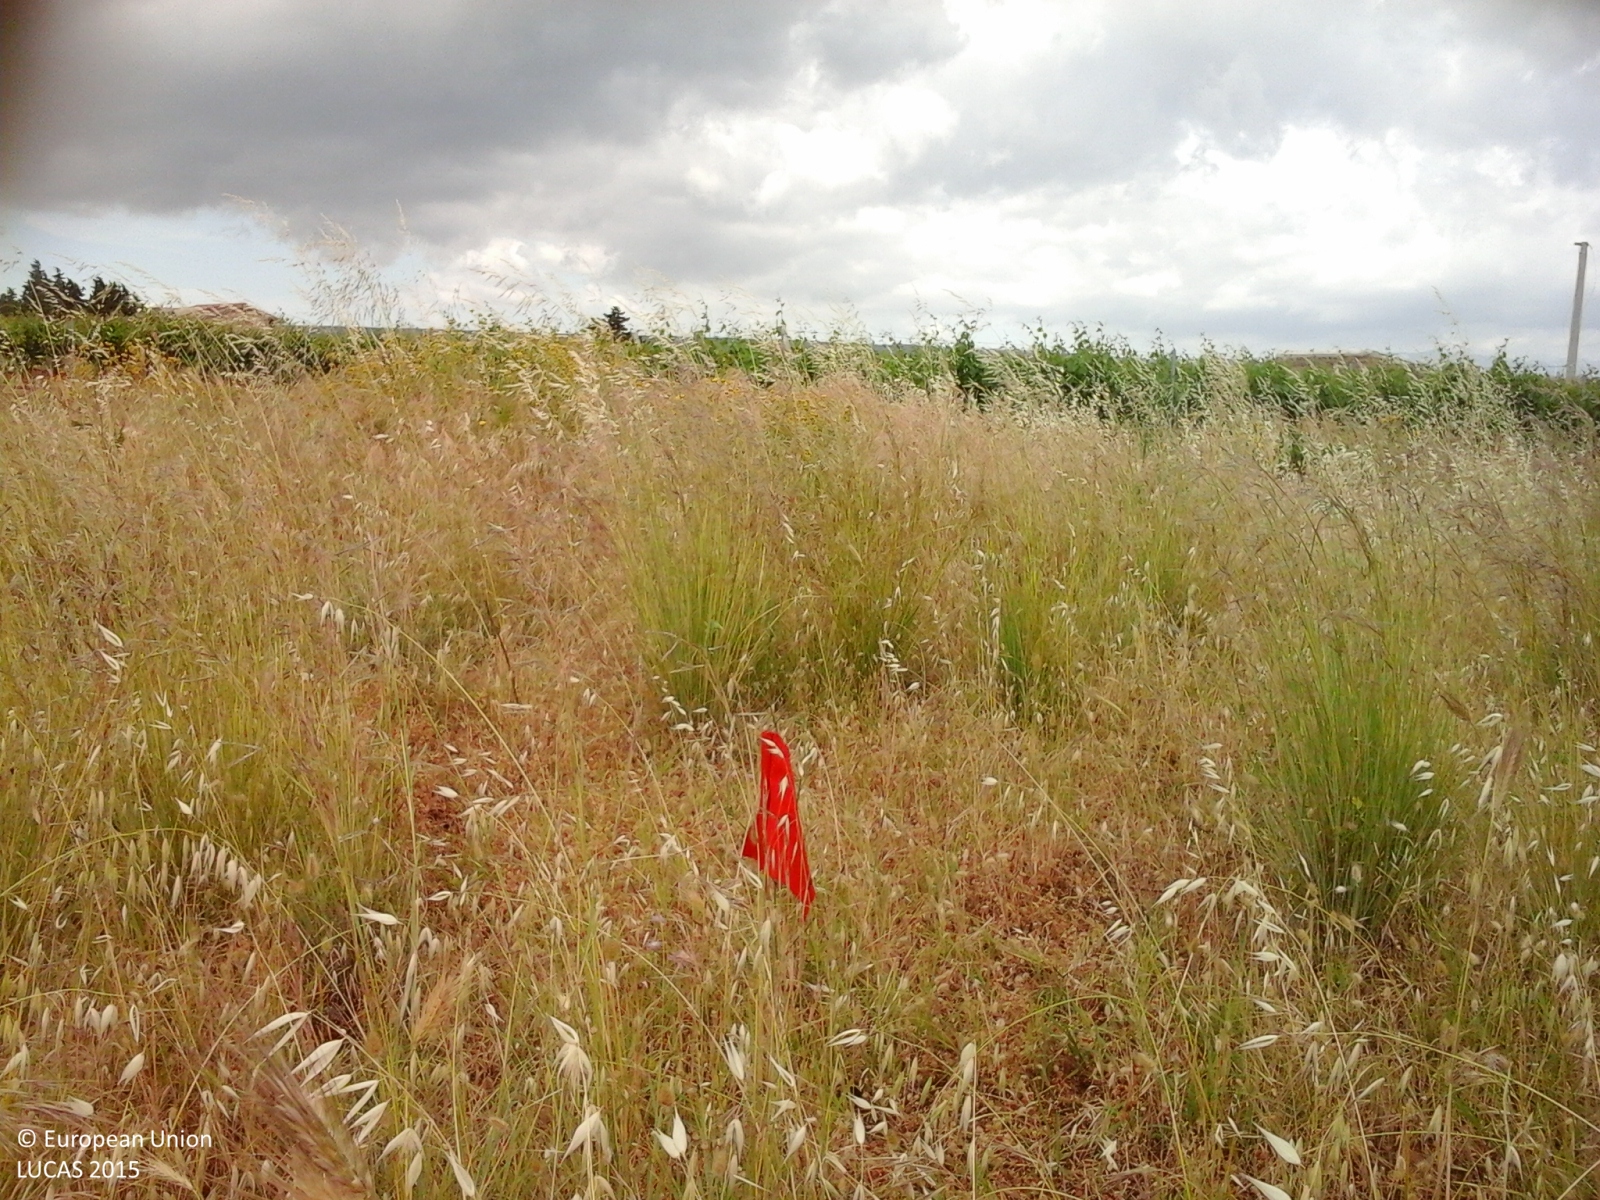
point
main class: Grassland
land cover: Spontaneously vegetated surfaces
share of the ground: > 75 %
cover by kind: herbaceous plants 90 %, consolidated bare surface 10 %
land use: Agriculture (excluding fallow land and kitchen gardens)
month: May
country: IT
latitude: 37.6121
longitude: 12.9119
